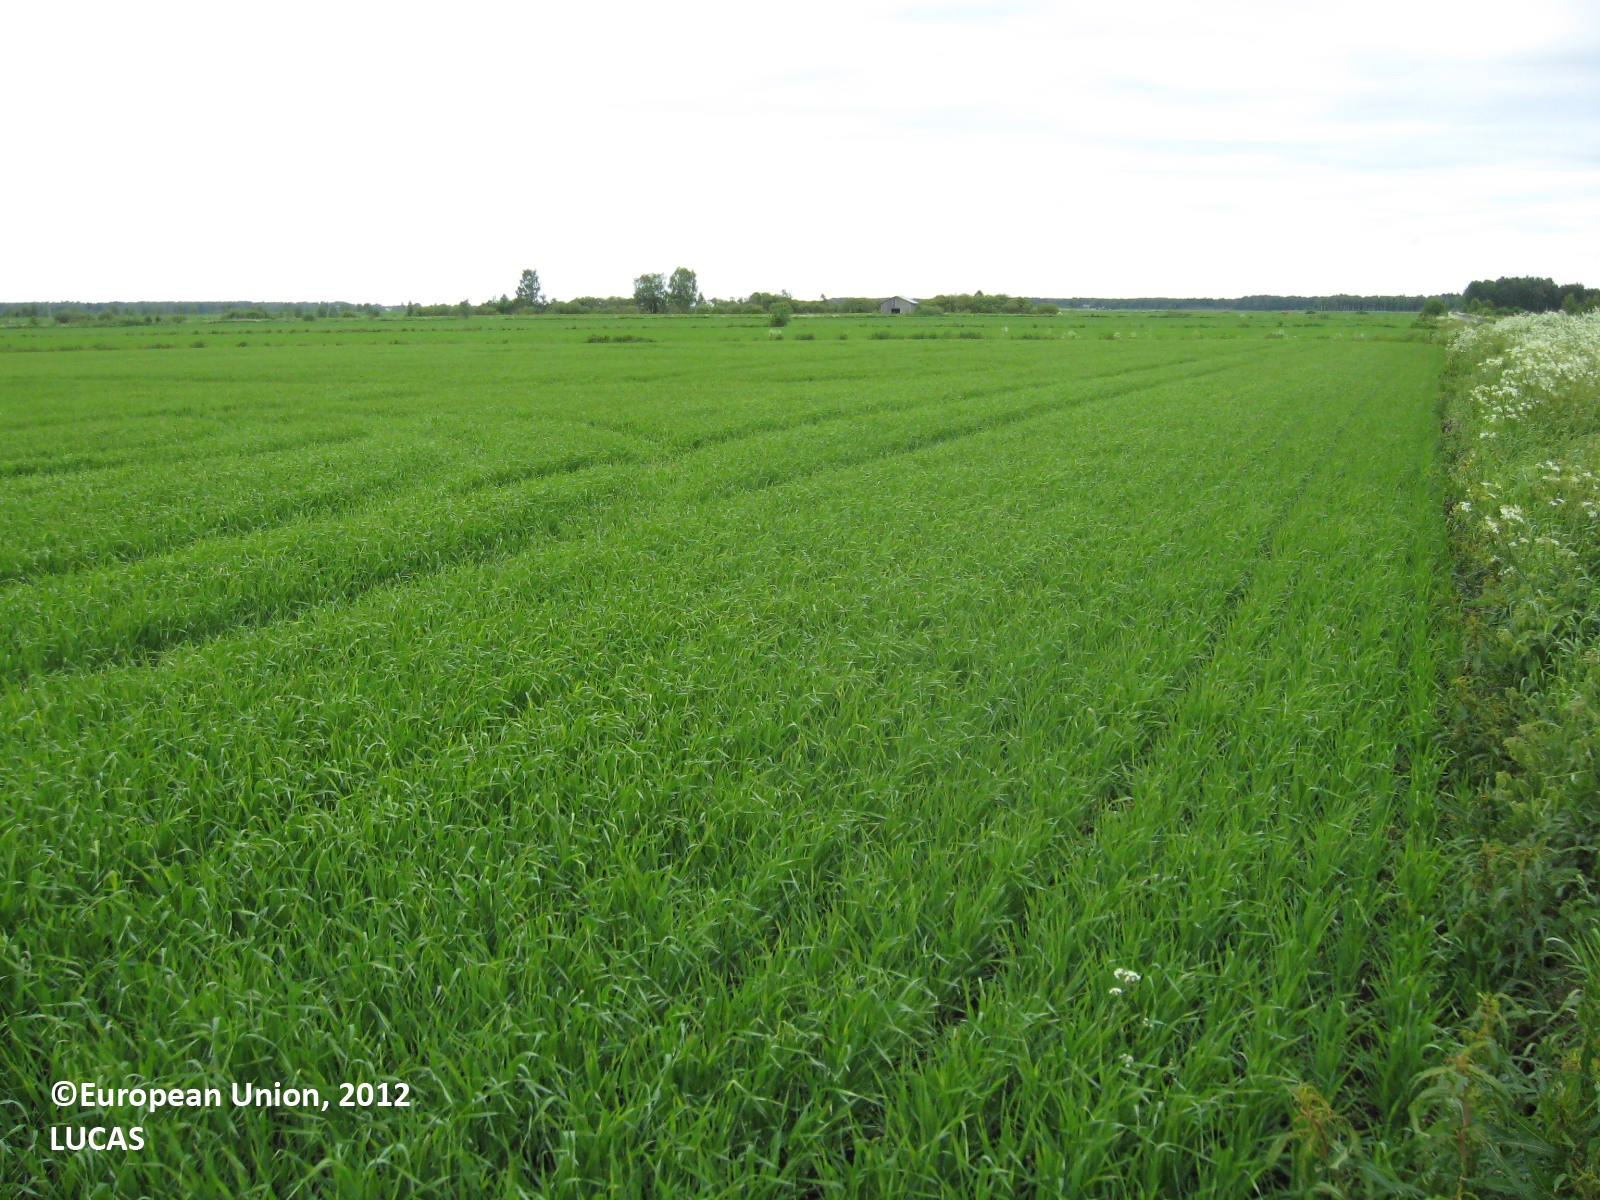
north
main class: Cropland
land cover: Barley
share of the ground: > 75 %
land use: Agriculture (excluding fallow land and kitchen gardens)
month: June
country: FI
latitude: 62.8681
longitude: 22.8132
